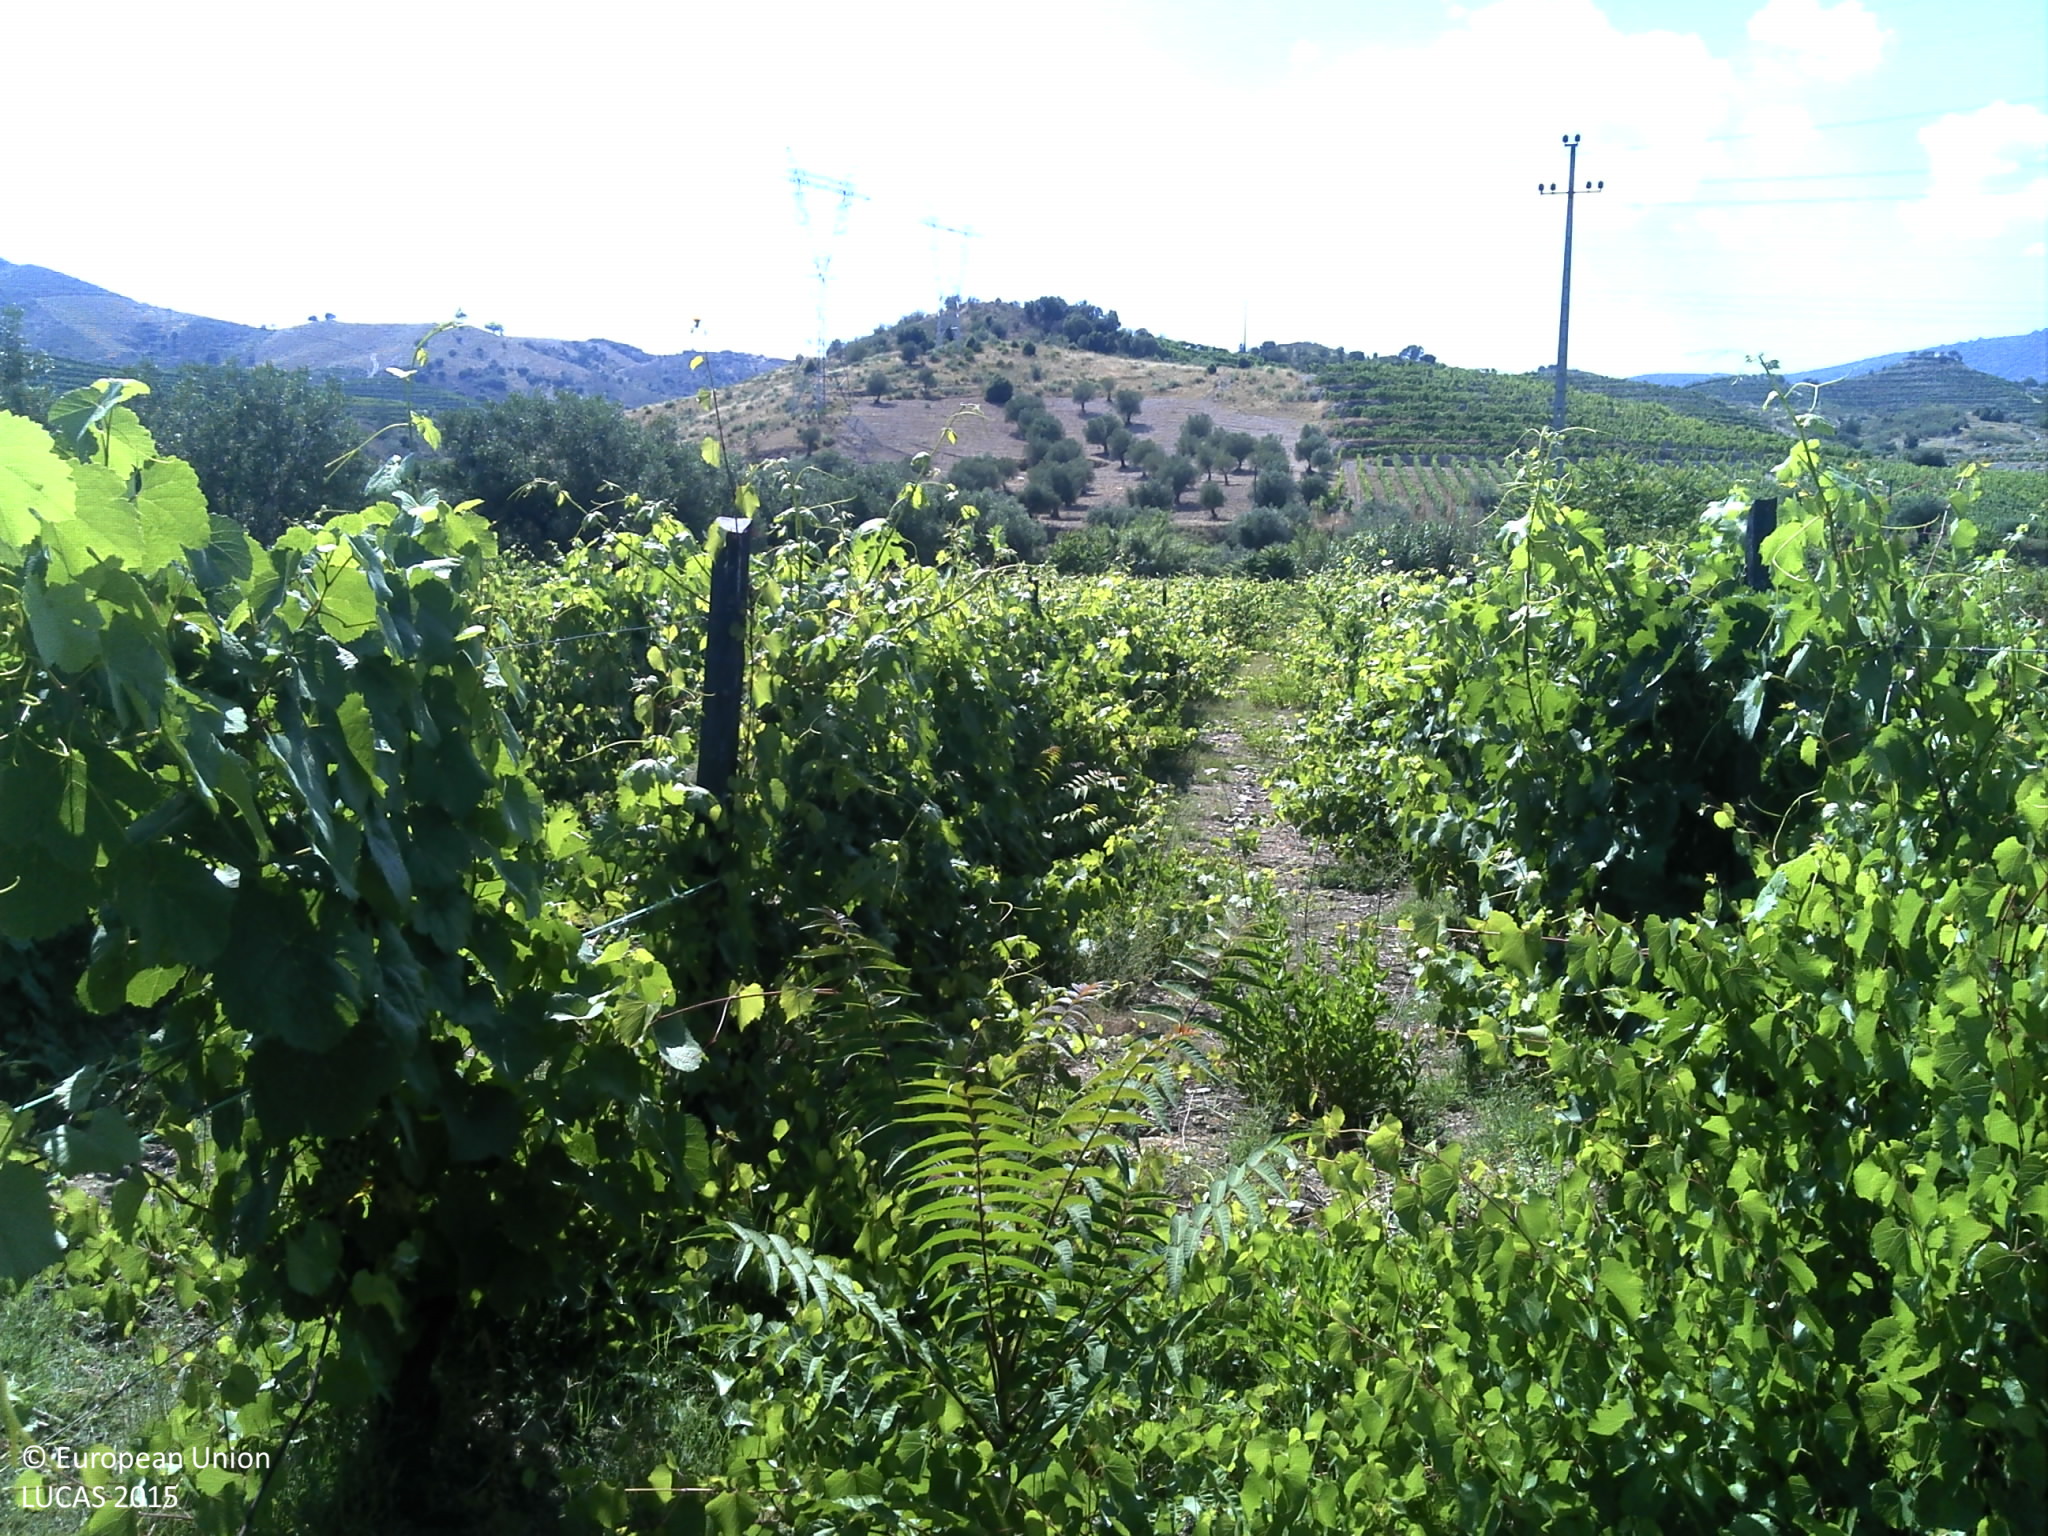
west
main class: Cropland
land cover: Vineyards
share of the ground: 25 - 50 %
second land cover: Grassland without tree/shrub cover
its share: 25 - 50 %
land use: Agriculture (excluding fallow land and kitchen gardens)
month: June
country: PT
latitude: 41.1260
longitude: -7.1332
